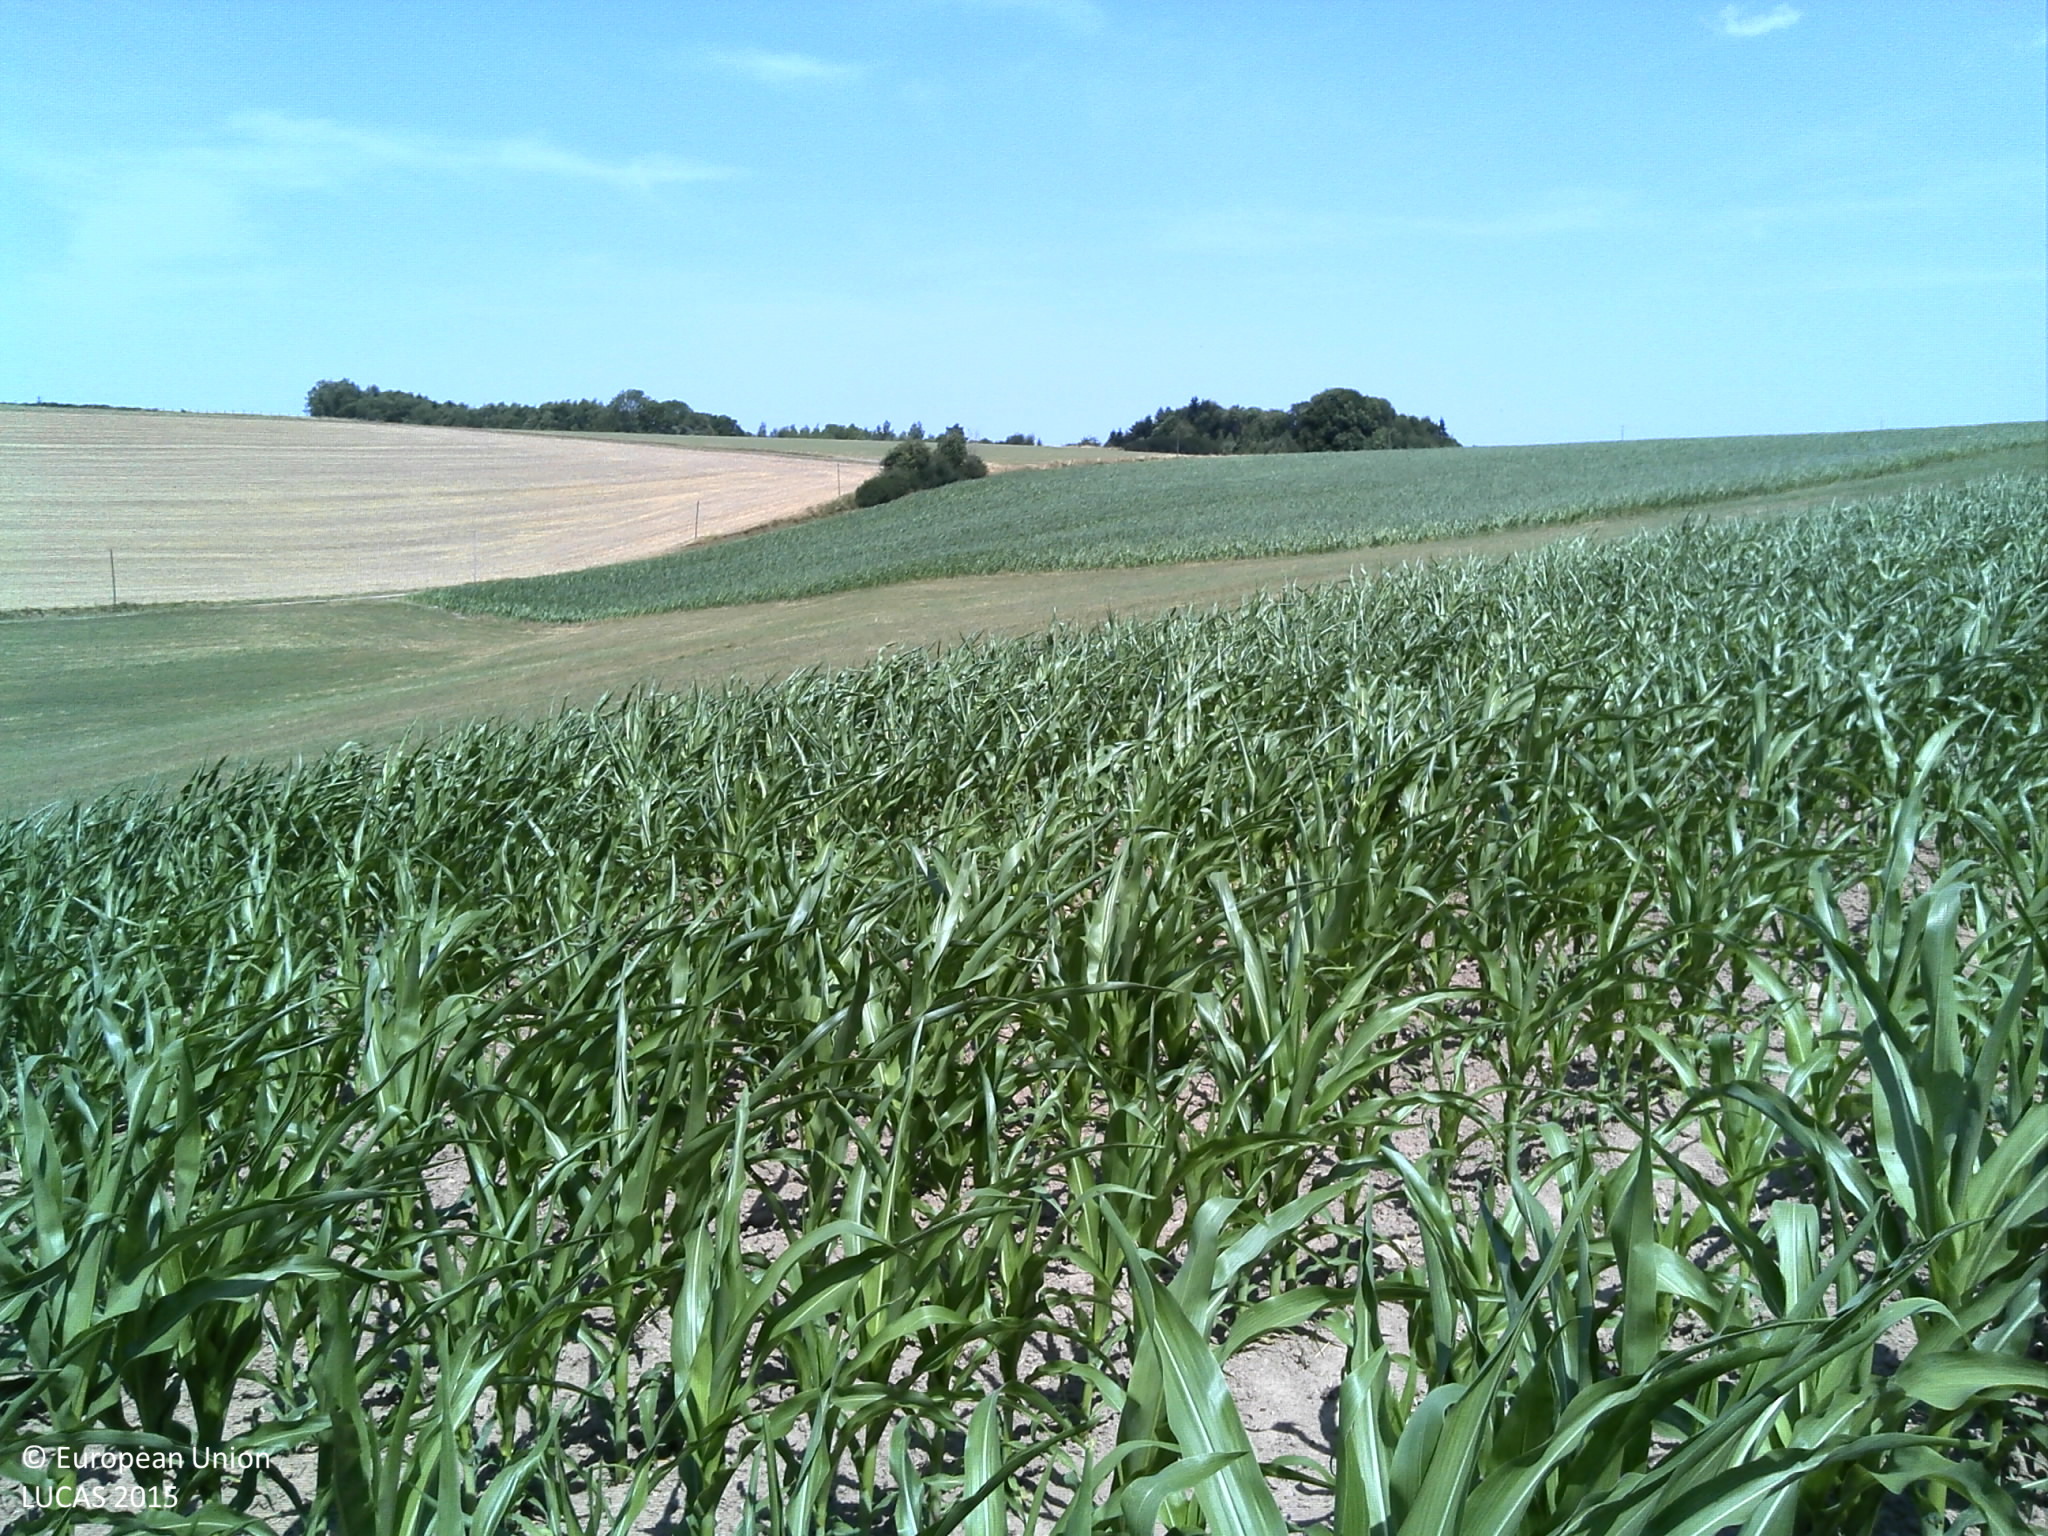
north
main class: Cropland
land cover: Maize
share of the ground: > 75 %
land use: Agriculture (excluding fallow land and kitchen gardens)
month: July
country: FR
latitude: 48.0538
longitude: 6.3112
